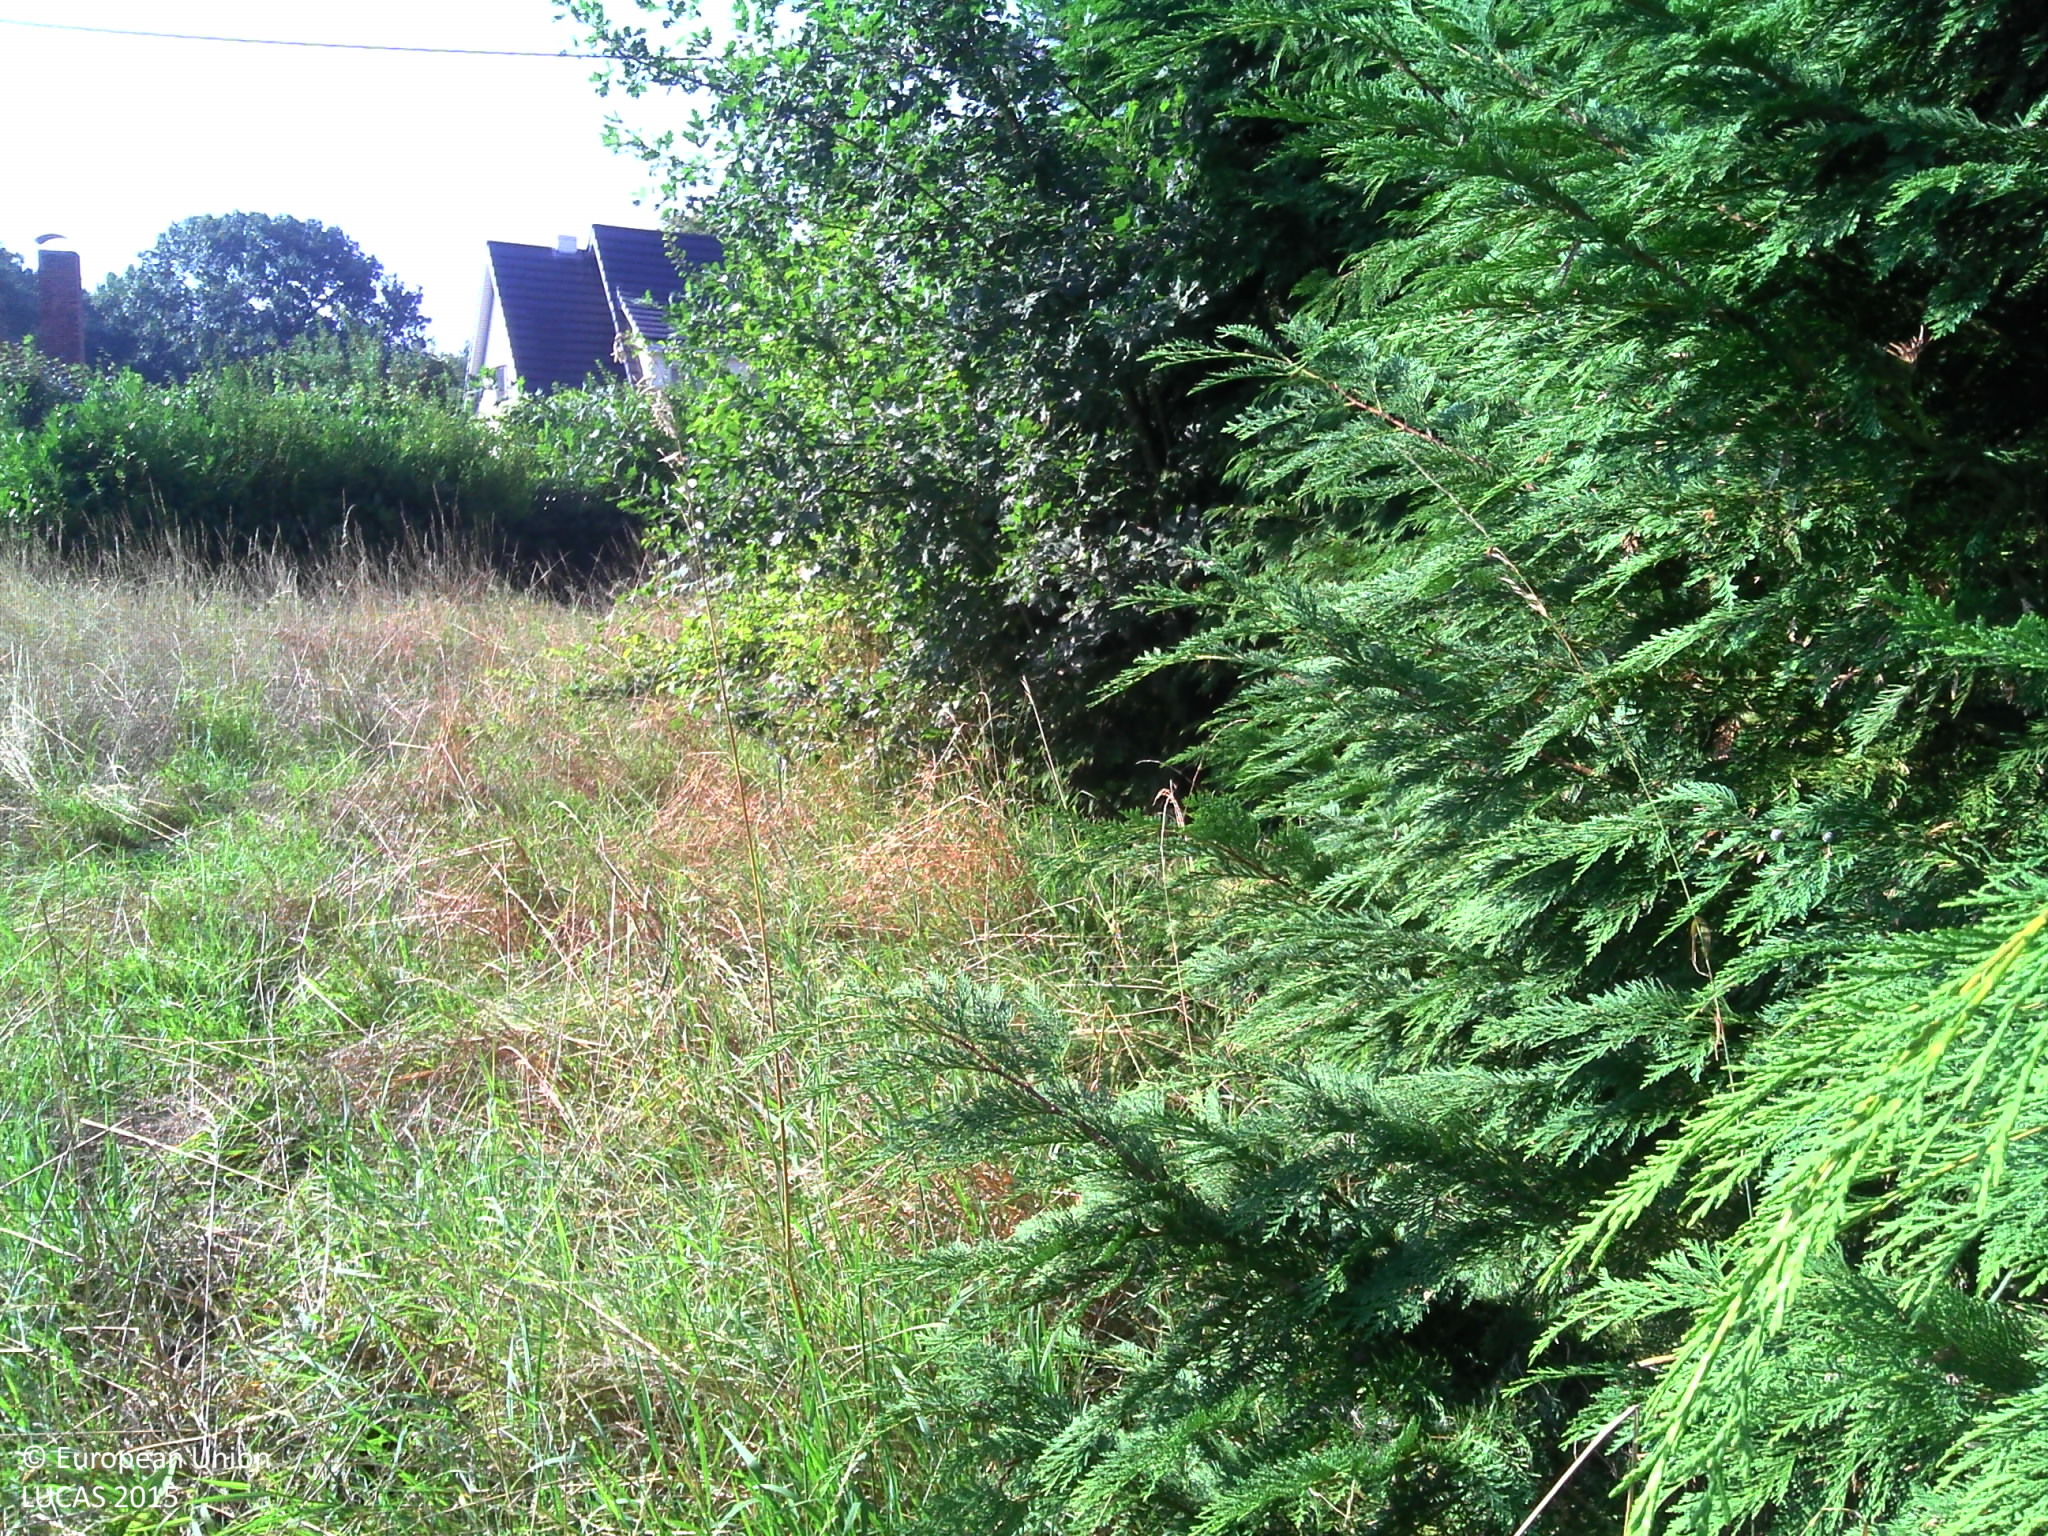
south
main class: Grassland
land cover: Spontaneously vegetated surfaces
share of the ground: > 75 %
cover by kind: herbaceous plants 100 %
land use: Residential
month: August
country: BE
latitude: 51.1810
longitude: 5.1765
